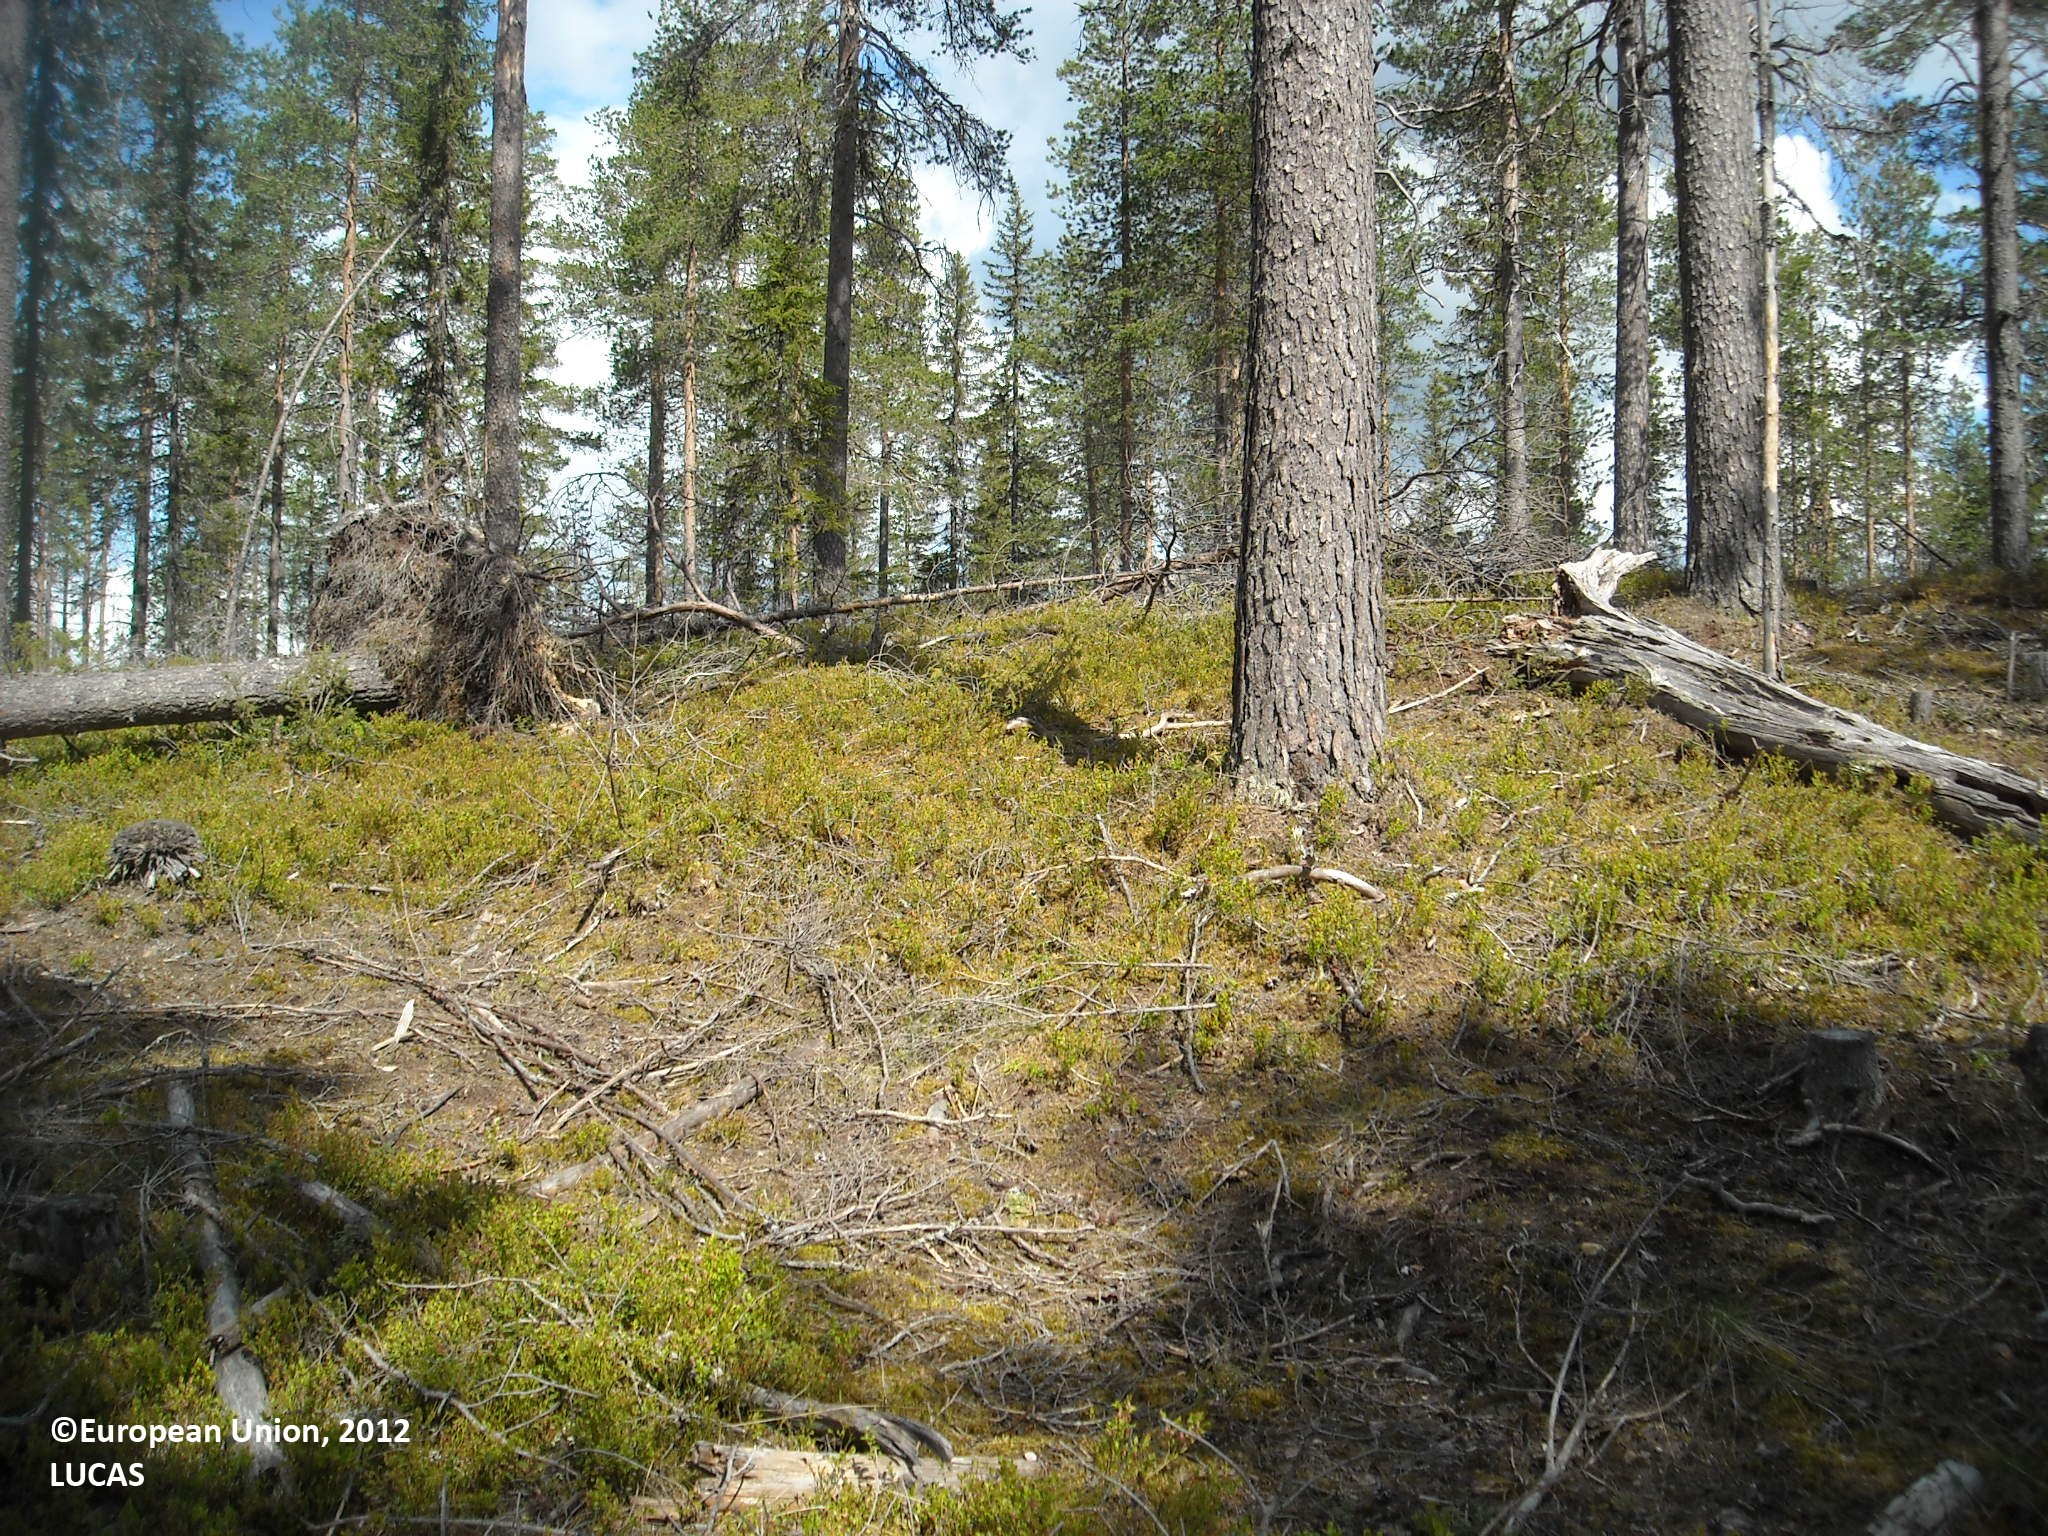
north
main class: Woodland
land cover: Pine dominated coniferous woodland
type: boreal forest
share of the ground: 50 - 75 %
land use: Forestry
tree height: > 5 m
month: June
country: FI
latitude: 65.3513
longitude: 27.8271
